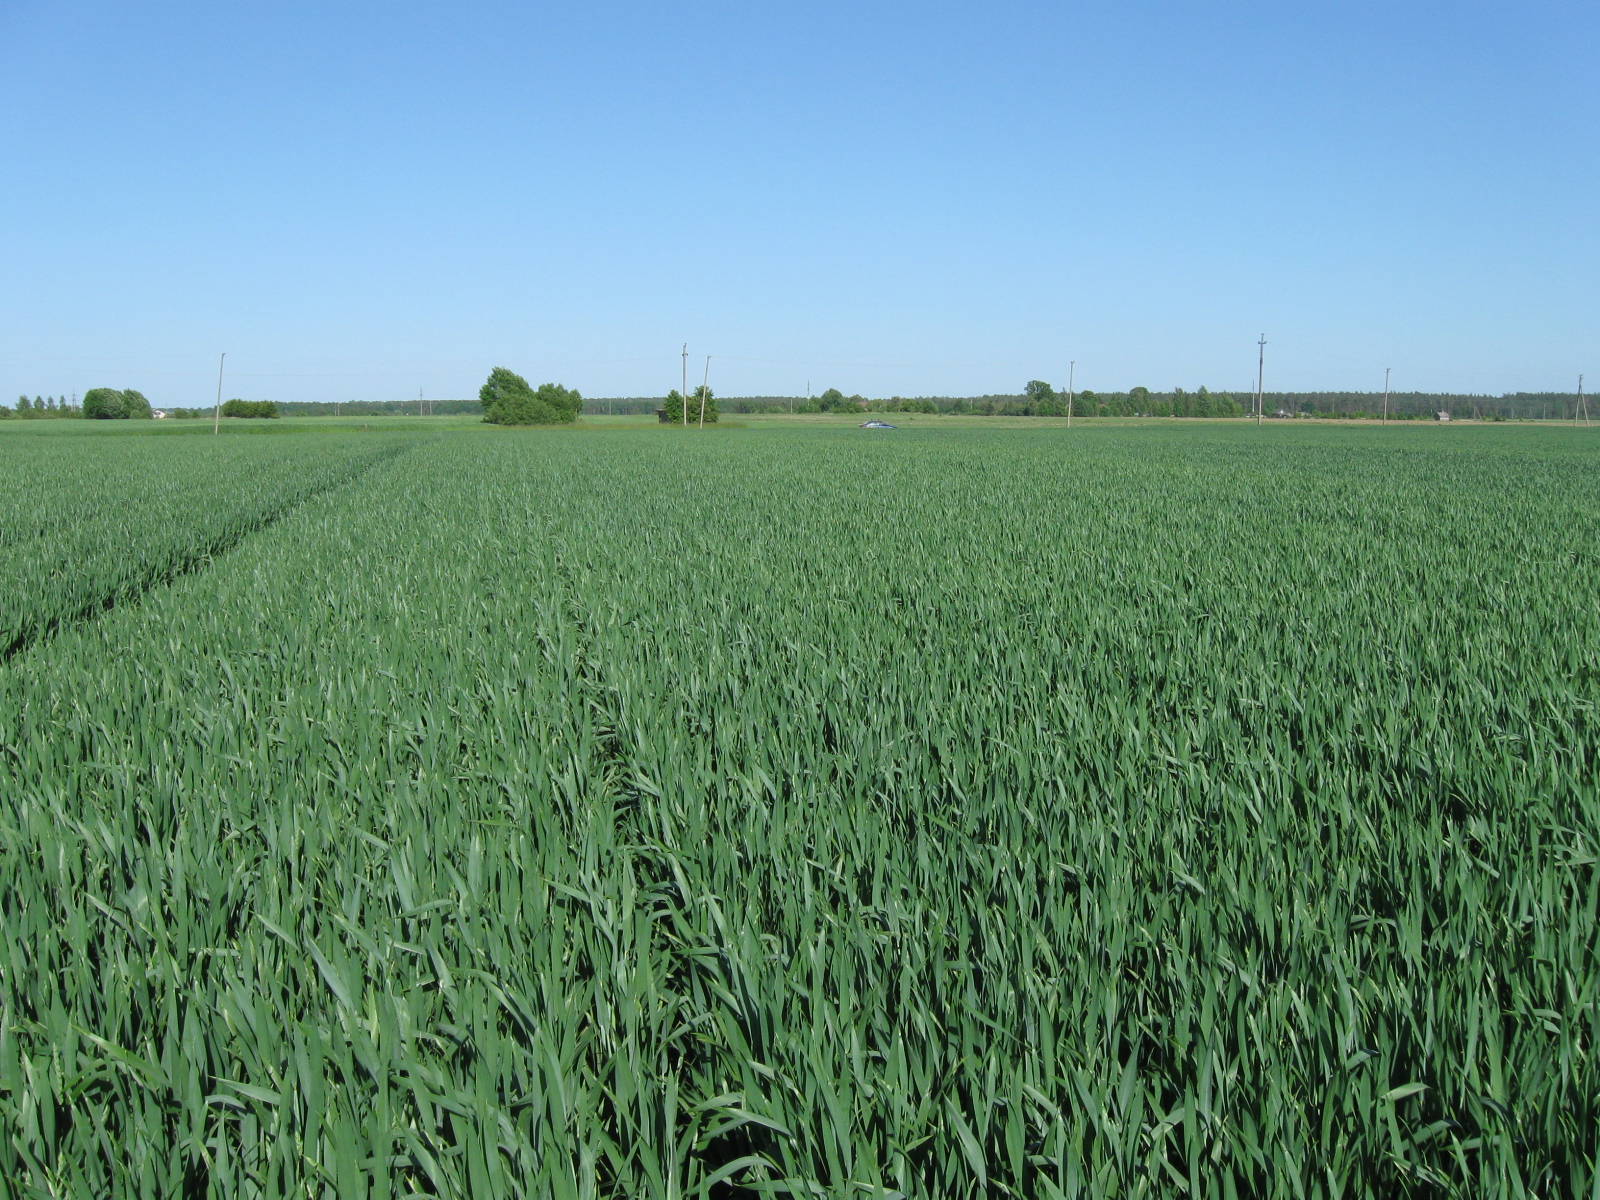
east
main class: Cropland
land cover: Common wheat
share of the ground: > 75 %
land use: Agriculture (excluding fallow land and kitchen gardens)
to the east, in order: Common wheat; Electric lines; Grassland without tree/shrub cover; Electric lines; Grassland without tree/shrub cover; Broadleaved woodland; Dry pulses
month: June
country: LT
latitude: 54.8344
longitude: 23.9623
